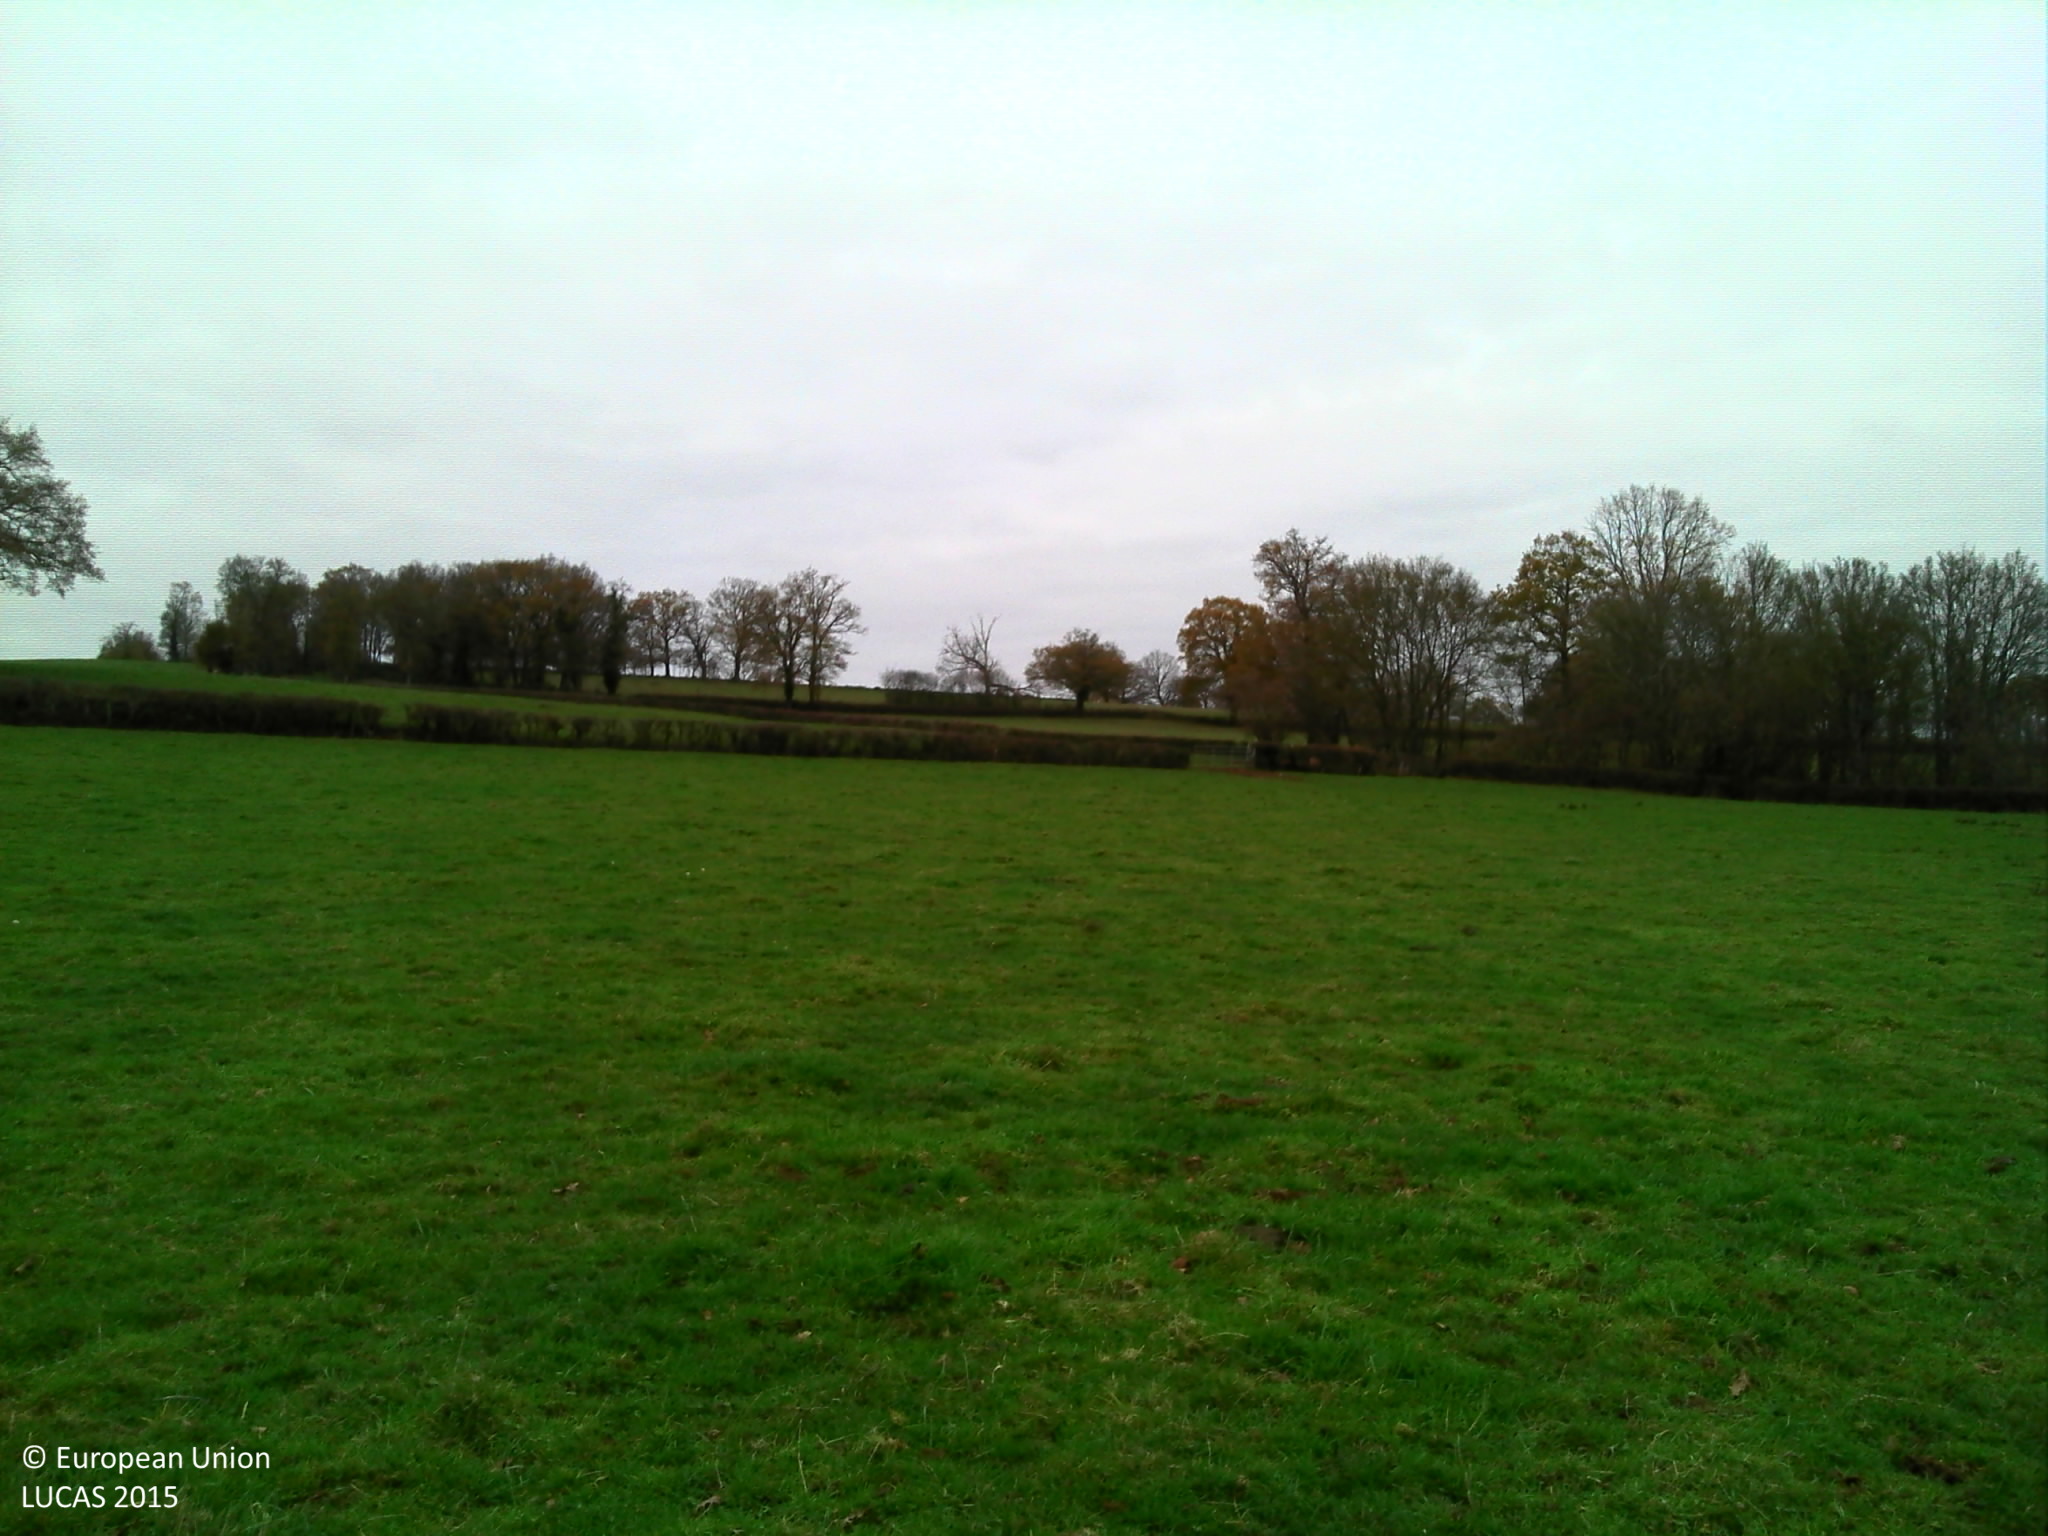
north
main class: Grassland
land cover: Grassland without tree/shrub cover
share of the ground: > 75 %
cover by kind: herbaceous plants 100 %
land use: Agriculture (excluding fallow land and kitchen gardens)
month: July
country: FR
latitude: 46.5355
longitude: 2.9690
